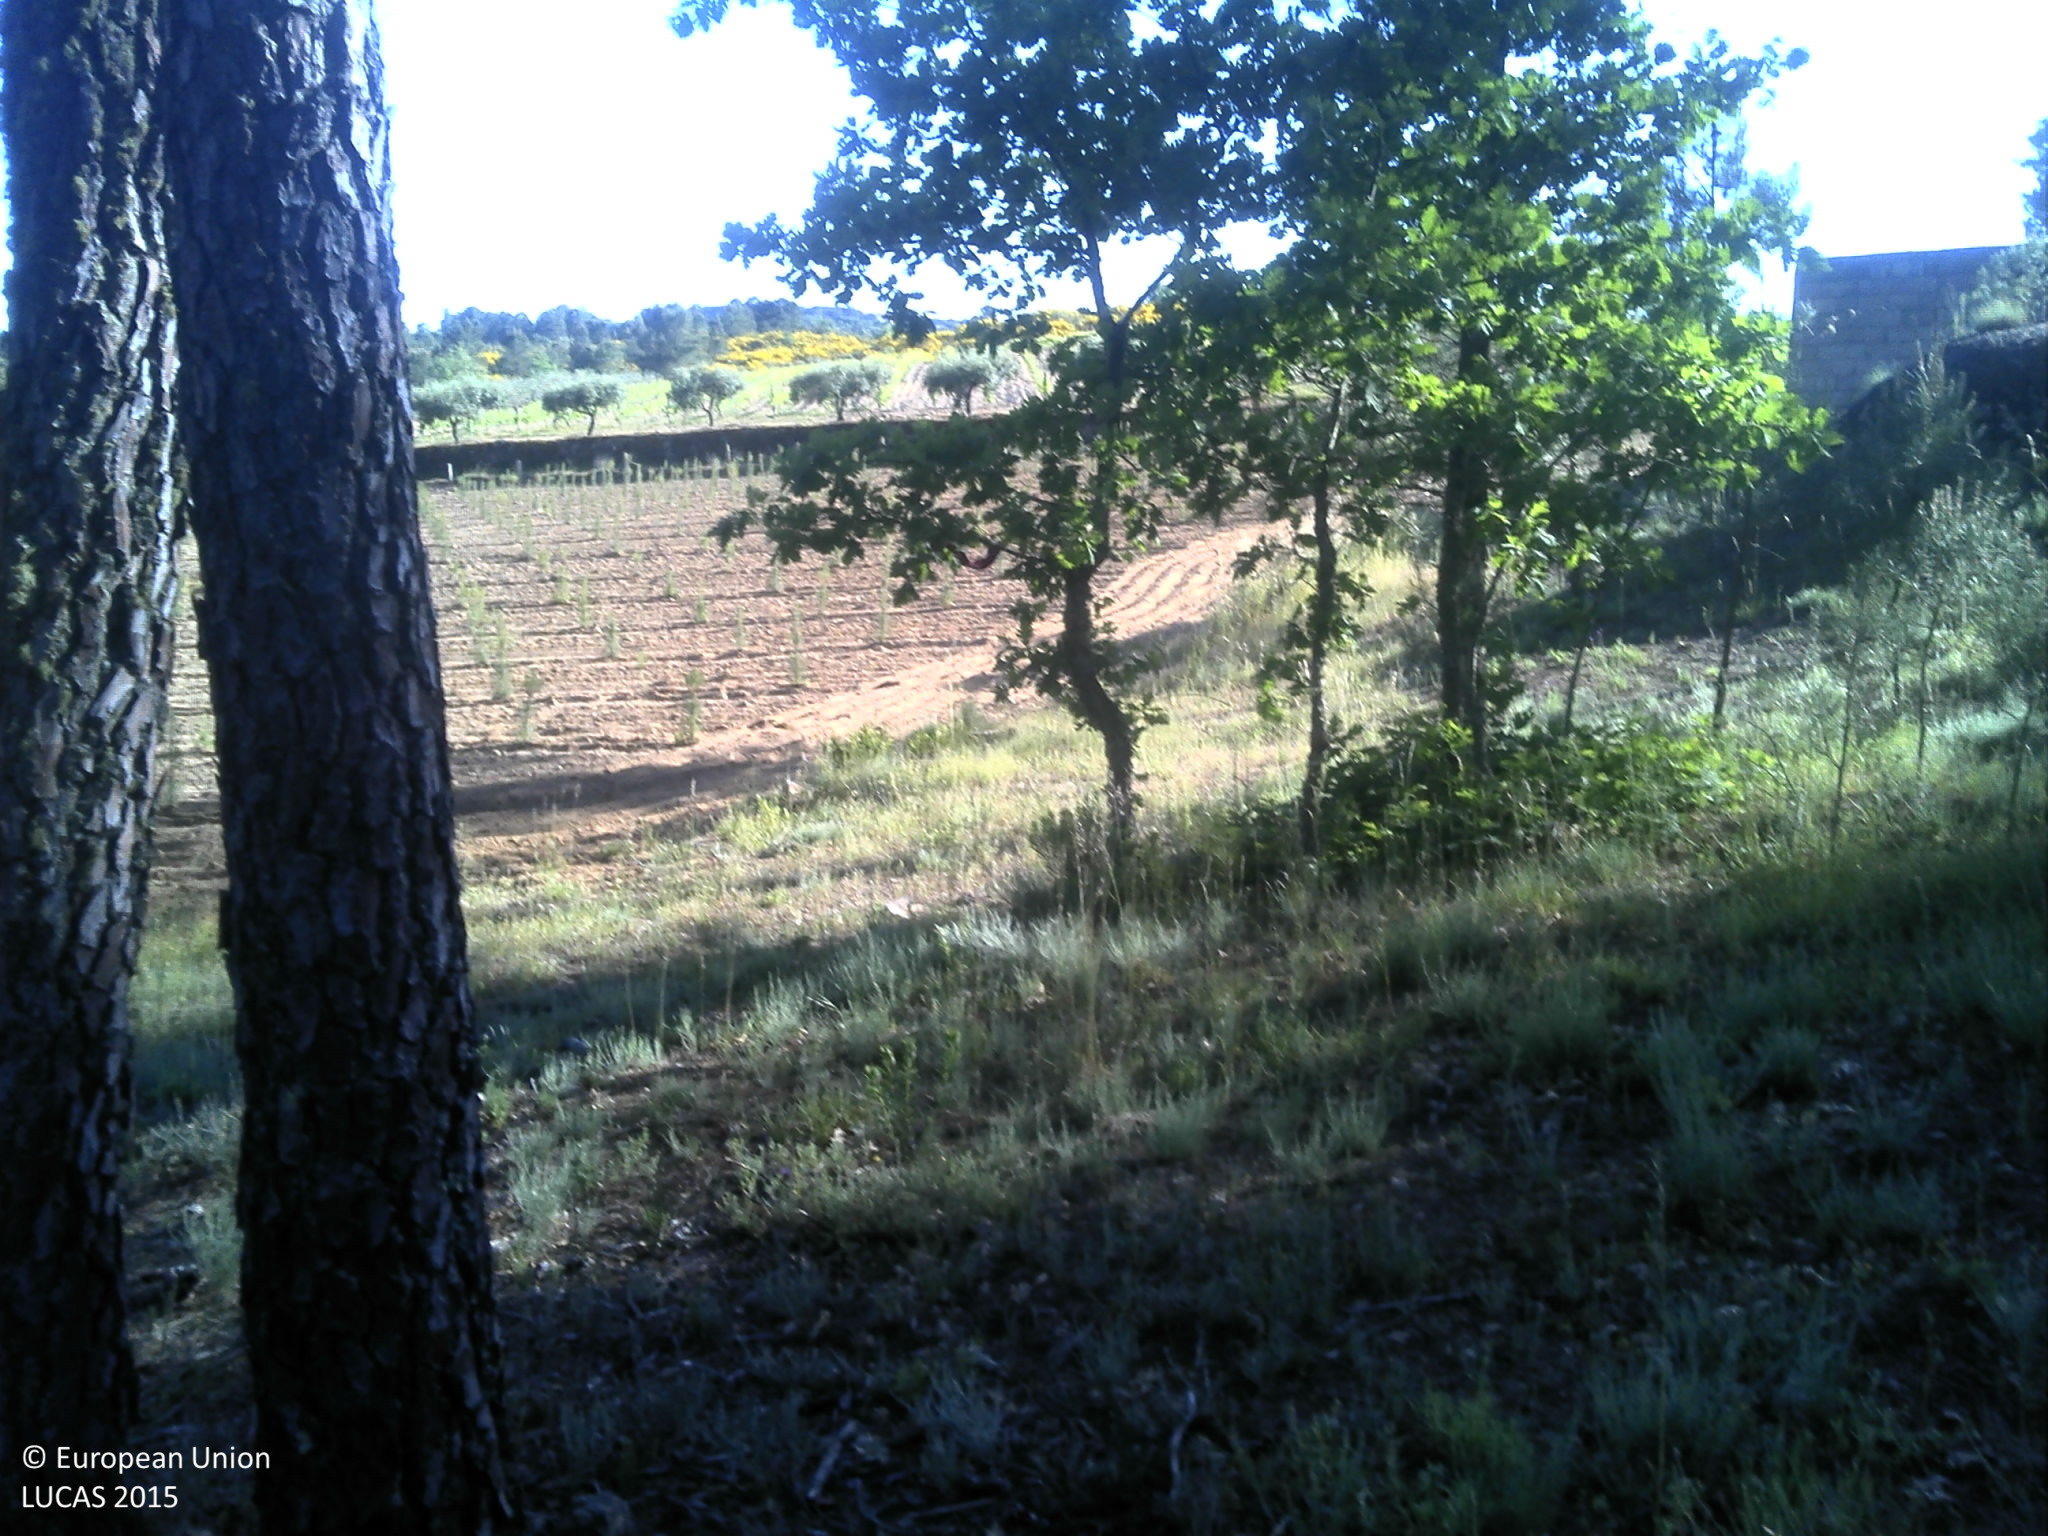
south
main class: Woodland
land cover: Pine dominated coniferous woodland
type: coniferous forest of the mediterranean region
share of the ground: 25 - 50 %
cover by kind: coniferous forest trees 60 %, shrubs 10 %, herbaceous plants 10 %, unconsolidated bare surface 10 %
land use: Forestry
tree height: > 5 m
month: May
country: PT
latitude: 40.7245
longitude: -7.2155
